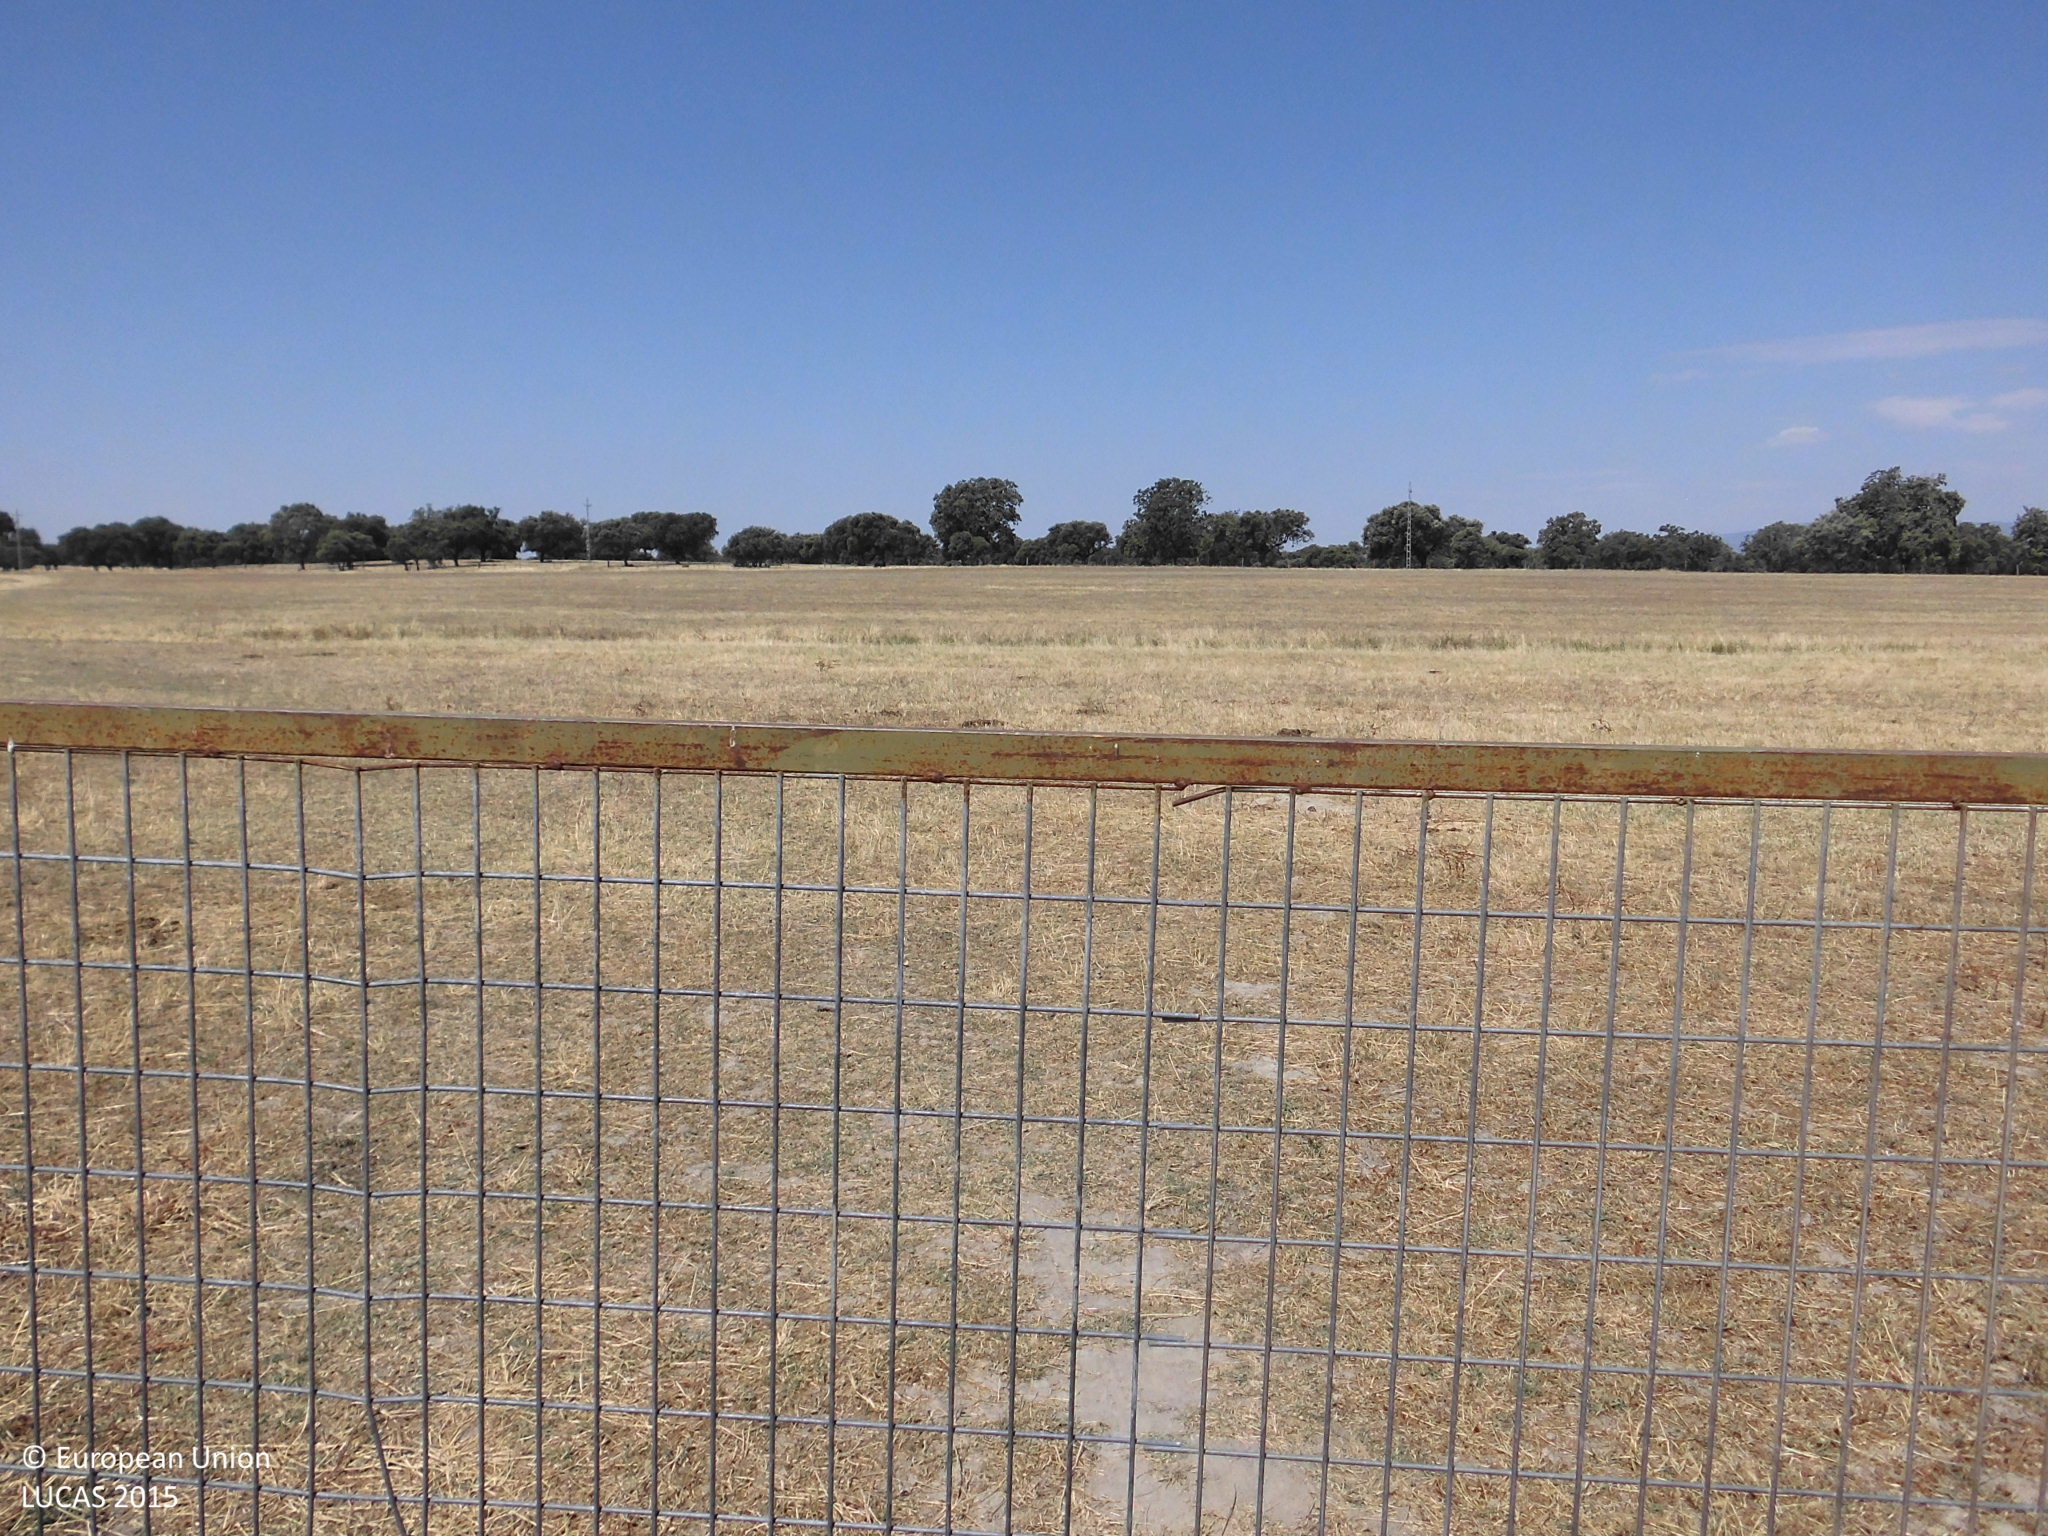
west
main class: Woodland
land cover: Broadleaved woodland
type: broadleaved evergreen forest
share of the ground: 10 - 25 %
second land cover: Grassland without tree/shrub cover
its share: > 75 %
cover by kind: herbaceous plants 85 %, broadleaved forest trees 10 %, unconsolidated bare surface 5 %
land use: Forestry
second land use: Agriculture (excluding fallow land and kitchen gardens)
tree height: > 5 m
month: June
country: ES
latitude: 40.0035
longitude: -5.4868
